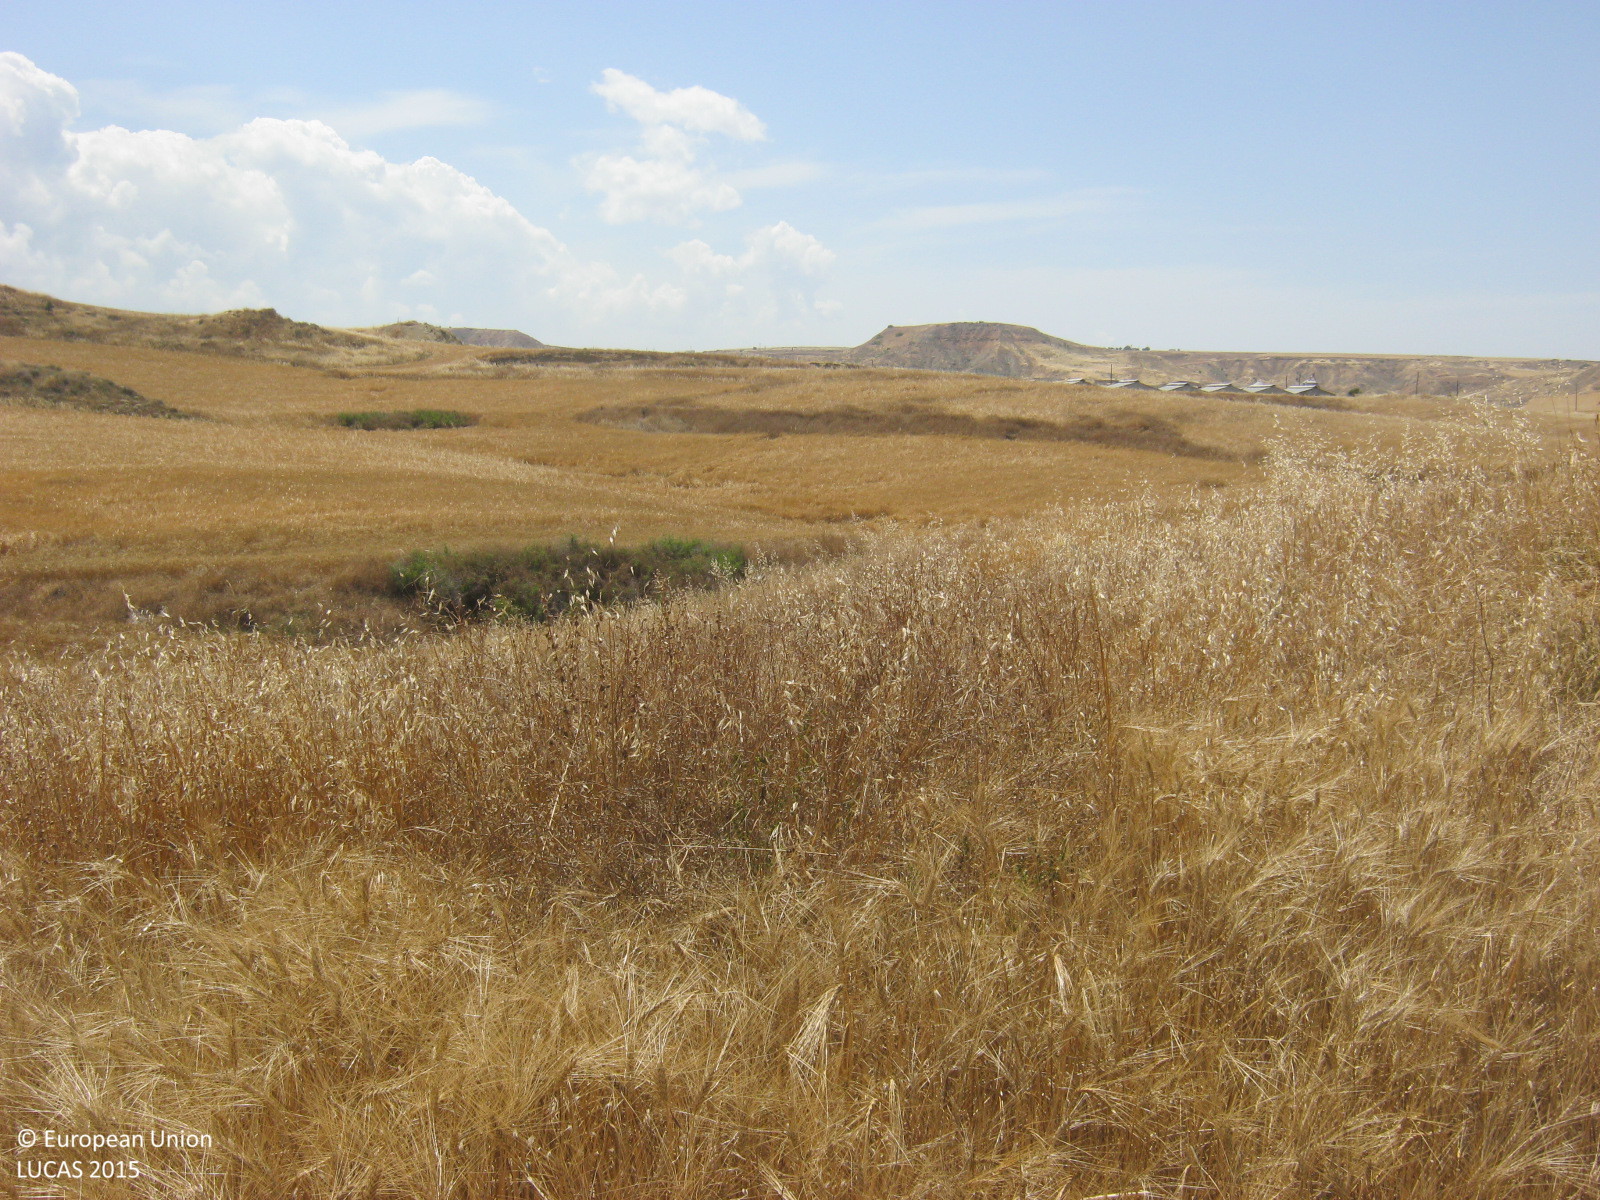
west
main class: Cropland
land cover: Common wheat
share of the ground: > 75 %
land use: Agriculture (excluding fallow land and kitchen gardens)
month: May
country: CY
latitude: 35.0834
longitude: 33.1150
